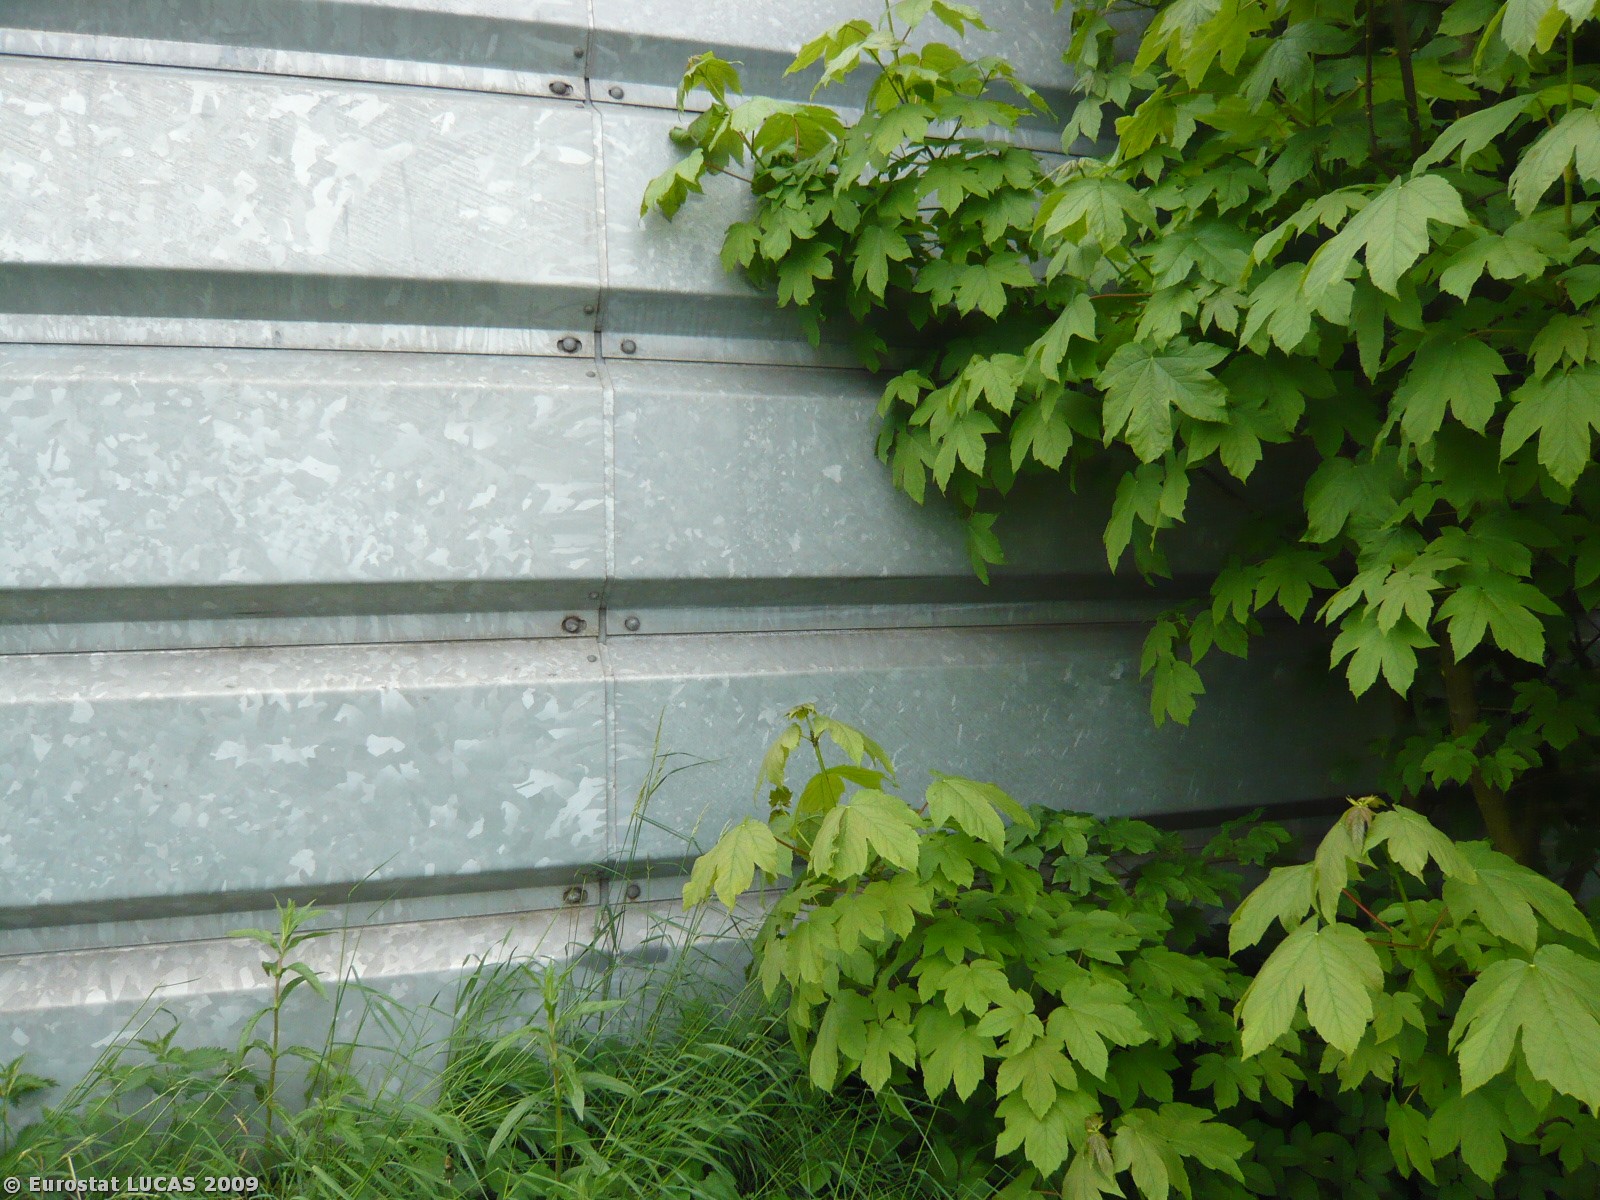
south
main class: Grassland
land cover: Grassland without tree/shrub cover
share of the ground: > 75 %
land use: Residential
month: May
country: DK
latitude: 55.4399
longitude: 11.6583
